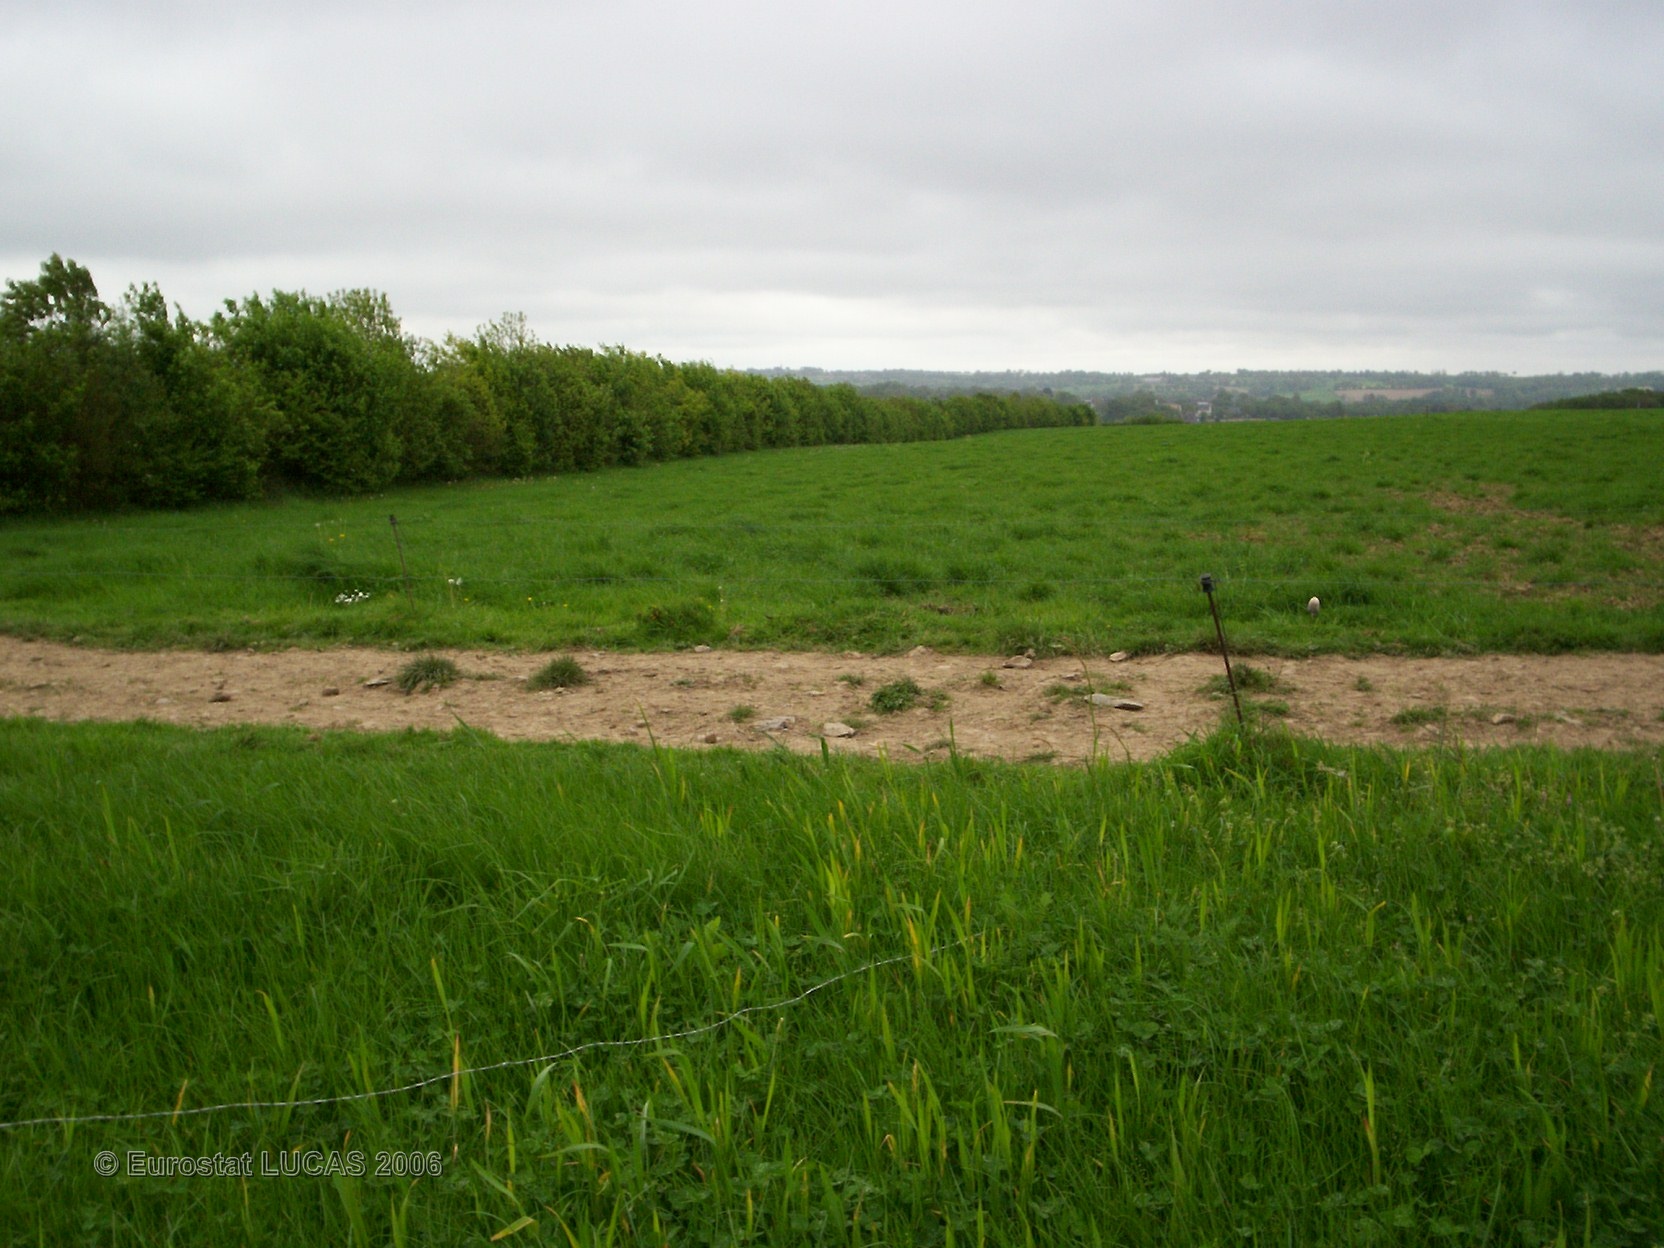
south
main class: Grassland
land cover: Grassland without tree/shrub cover
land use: Agriculture (excluding fallow land and kitchen gardens)
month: May
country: FR
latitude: 48.2899
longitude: -2.8300
